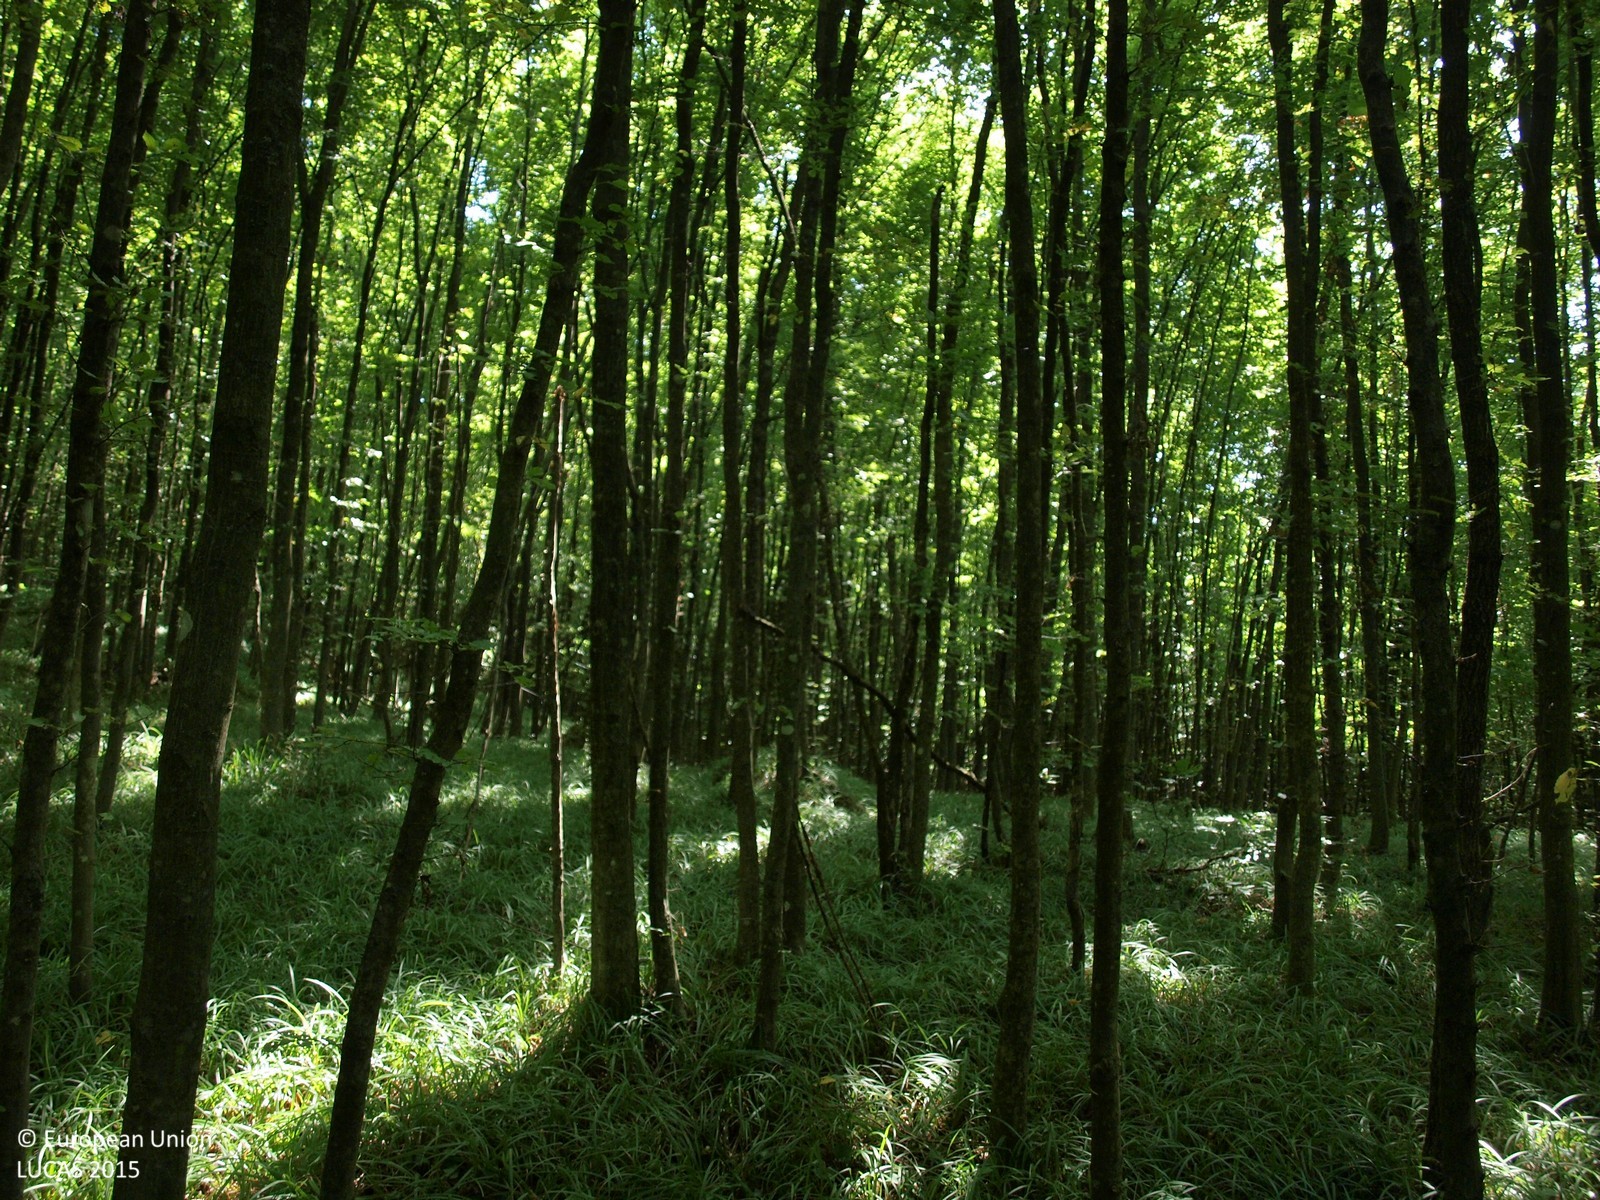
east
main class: Woodland
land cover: Broadleaved woodland
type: mesophytic deciduous forest
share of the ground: > 75 %
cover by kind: broadleaved forest trees 100 %
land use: Forestry
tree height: > 5 m
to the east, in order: Broadleaved woodland; Tracks; Broadleaved woodland
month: August
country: HR
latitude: 46.0154
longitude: 16.3929
